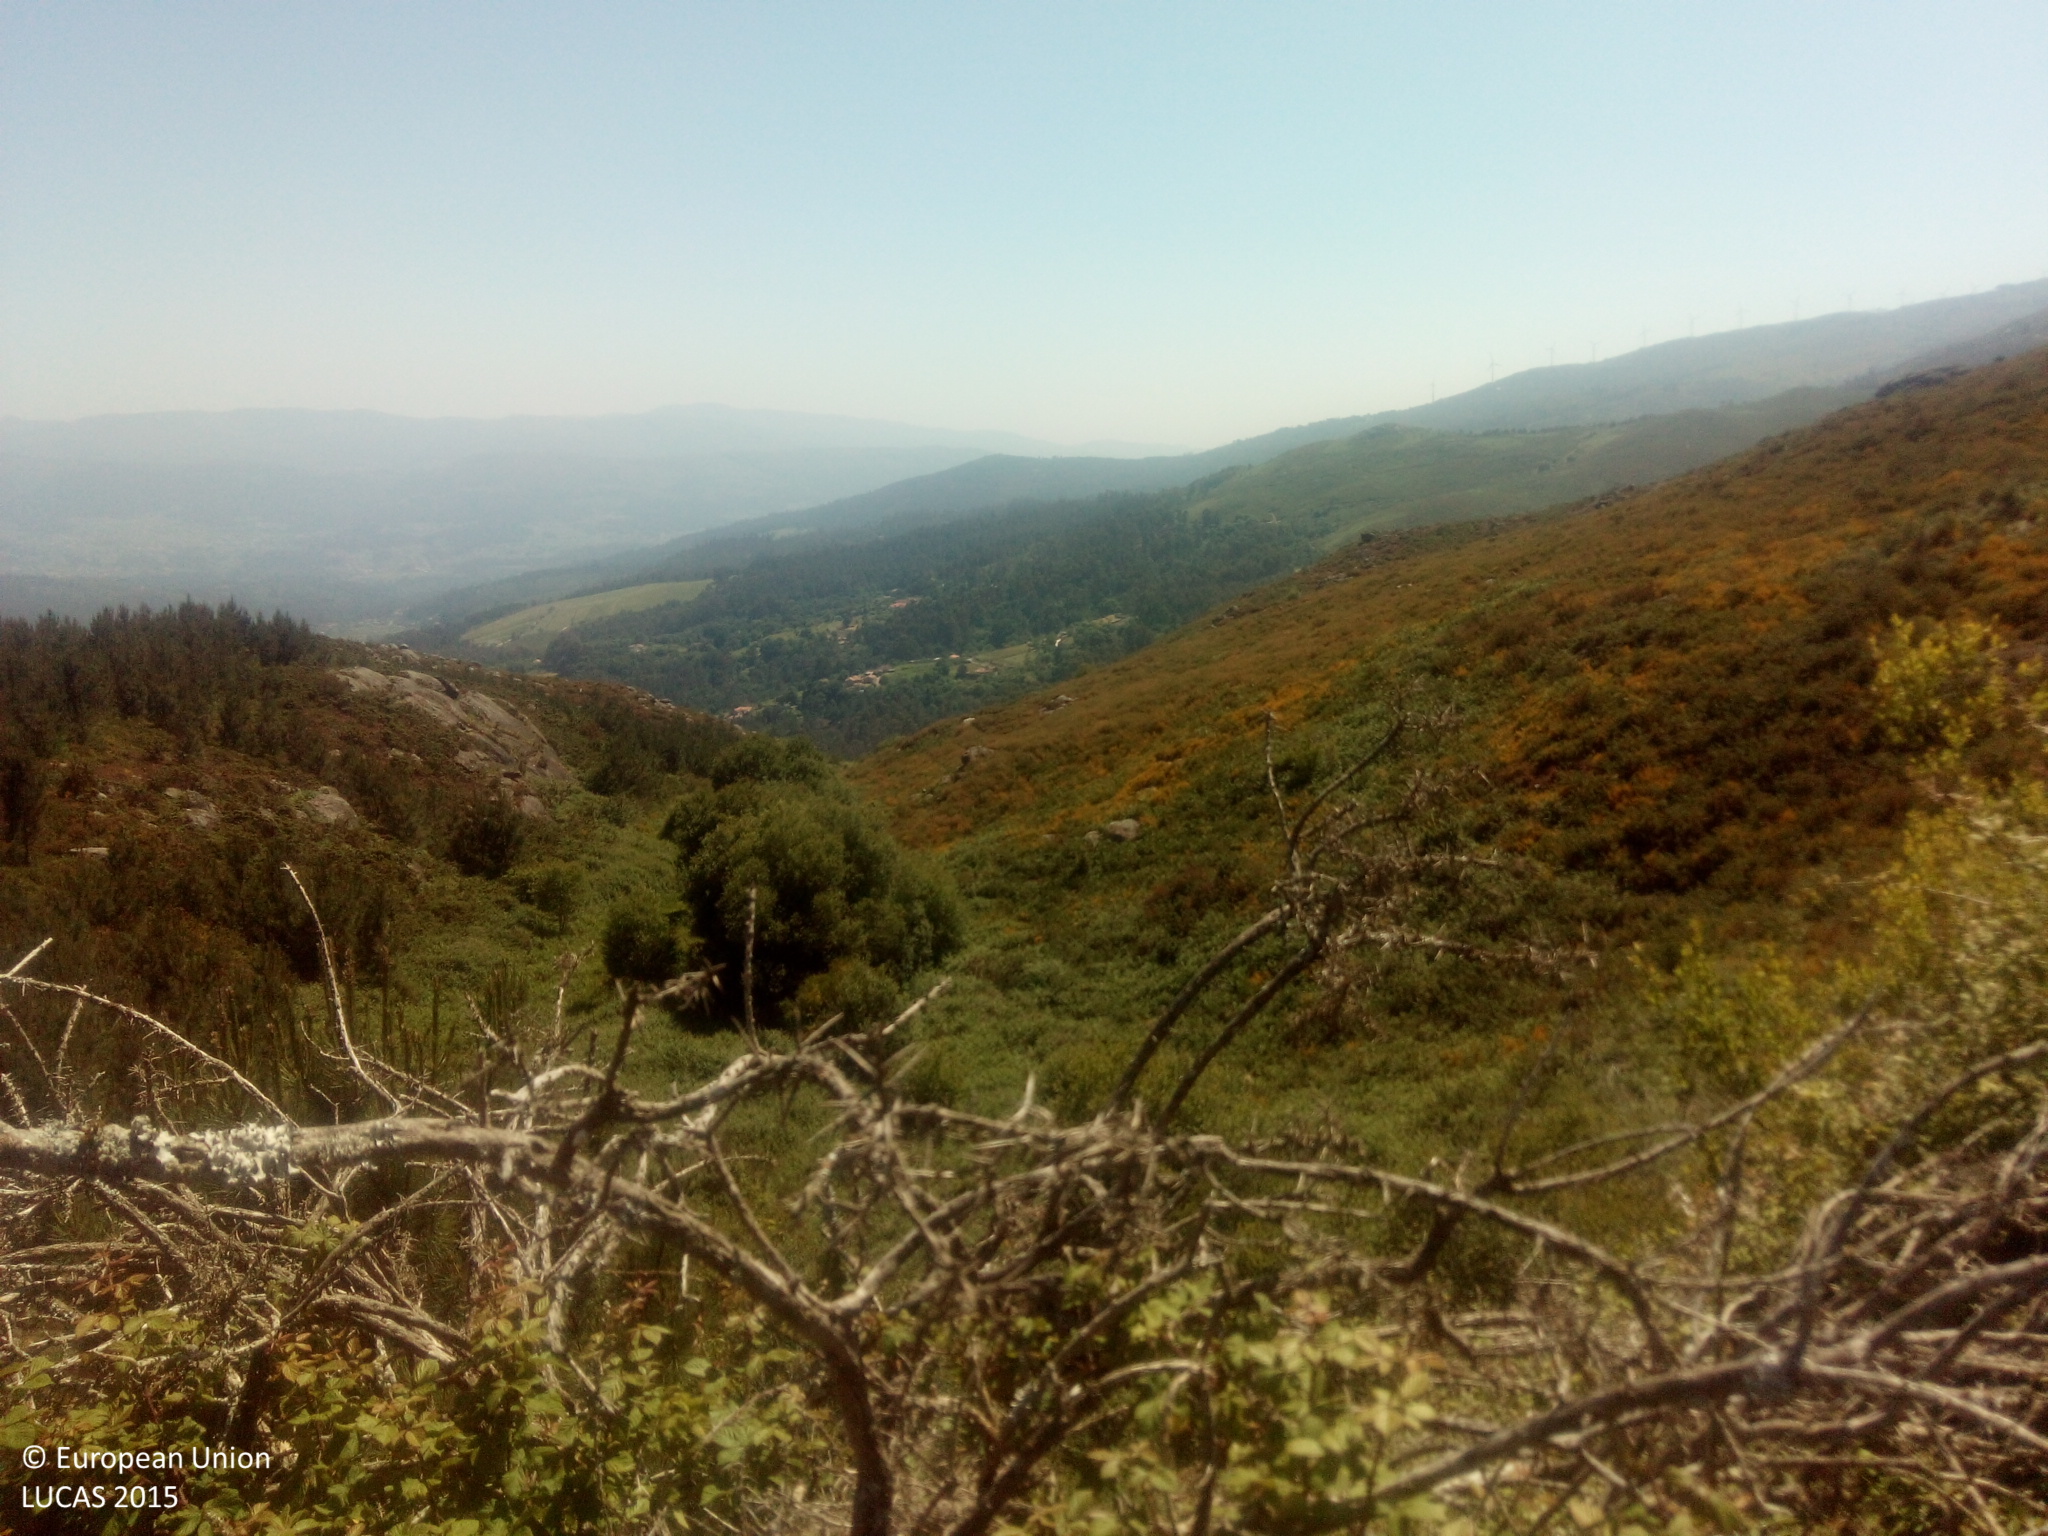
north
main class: Shrubland
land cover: Shrubland without tree cover
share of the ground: > 75 %
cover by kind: shrubs 70 %, consolidated bare surface 30 %
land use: Semi-natural and natural areas not in use
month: June
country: ES
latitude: 42.1869
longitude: -8.3110
